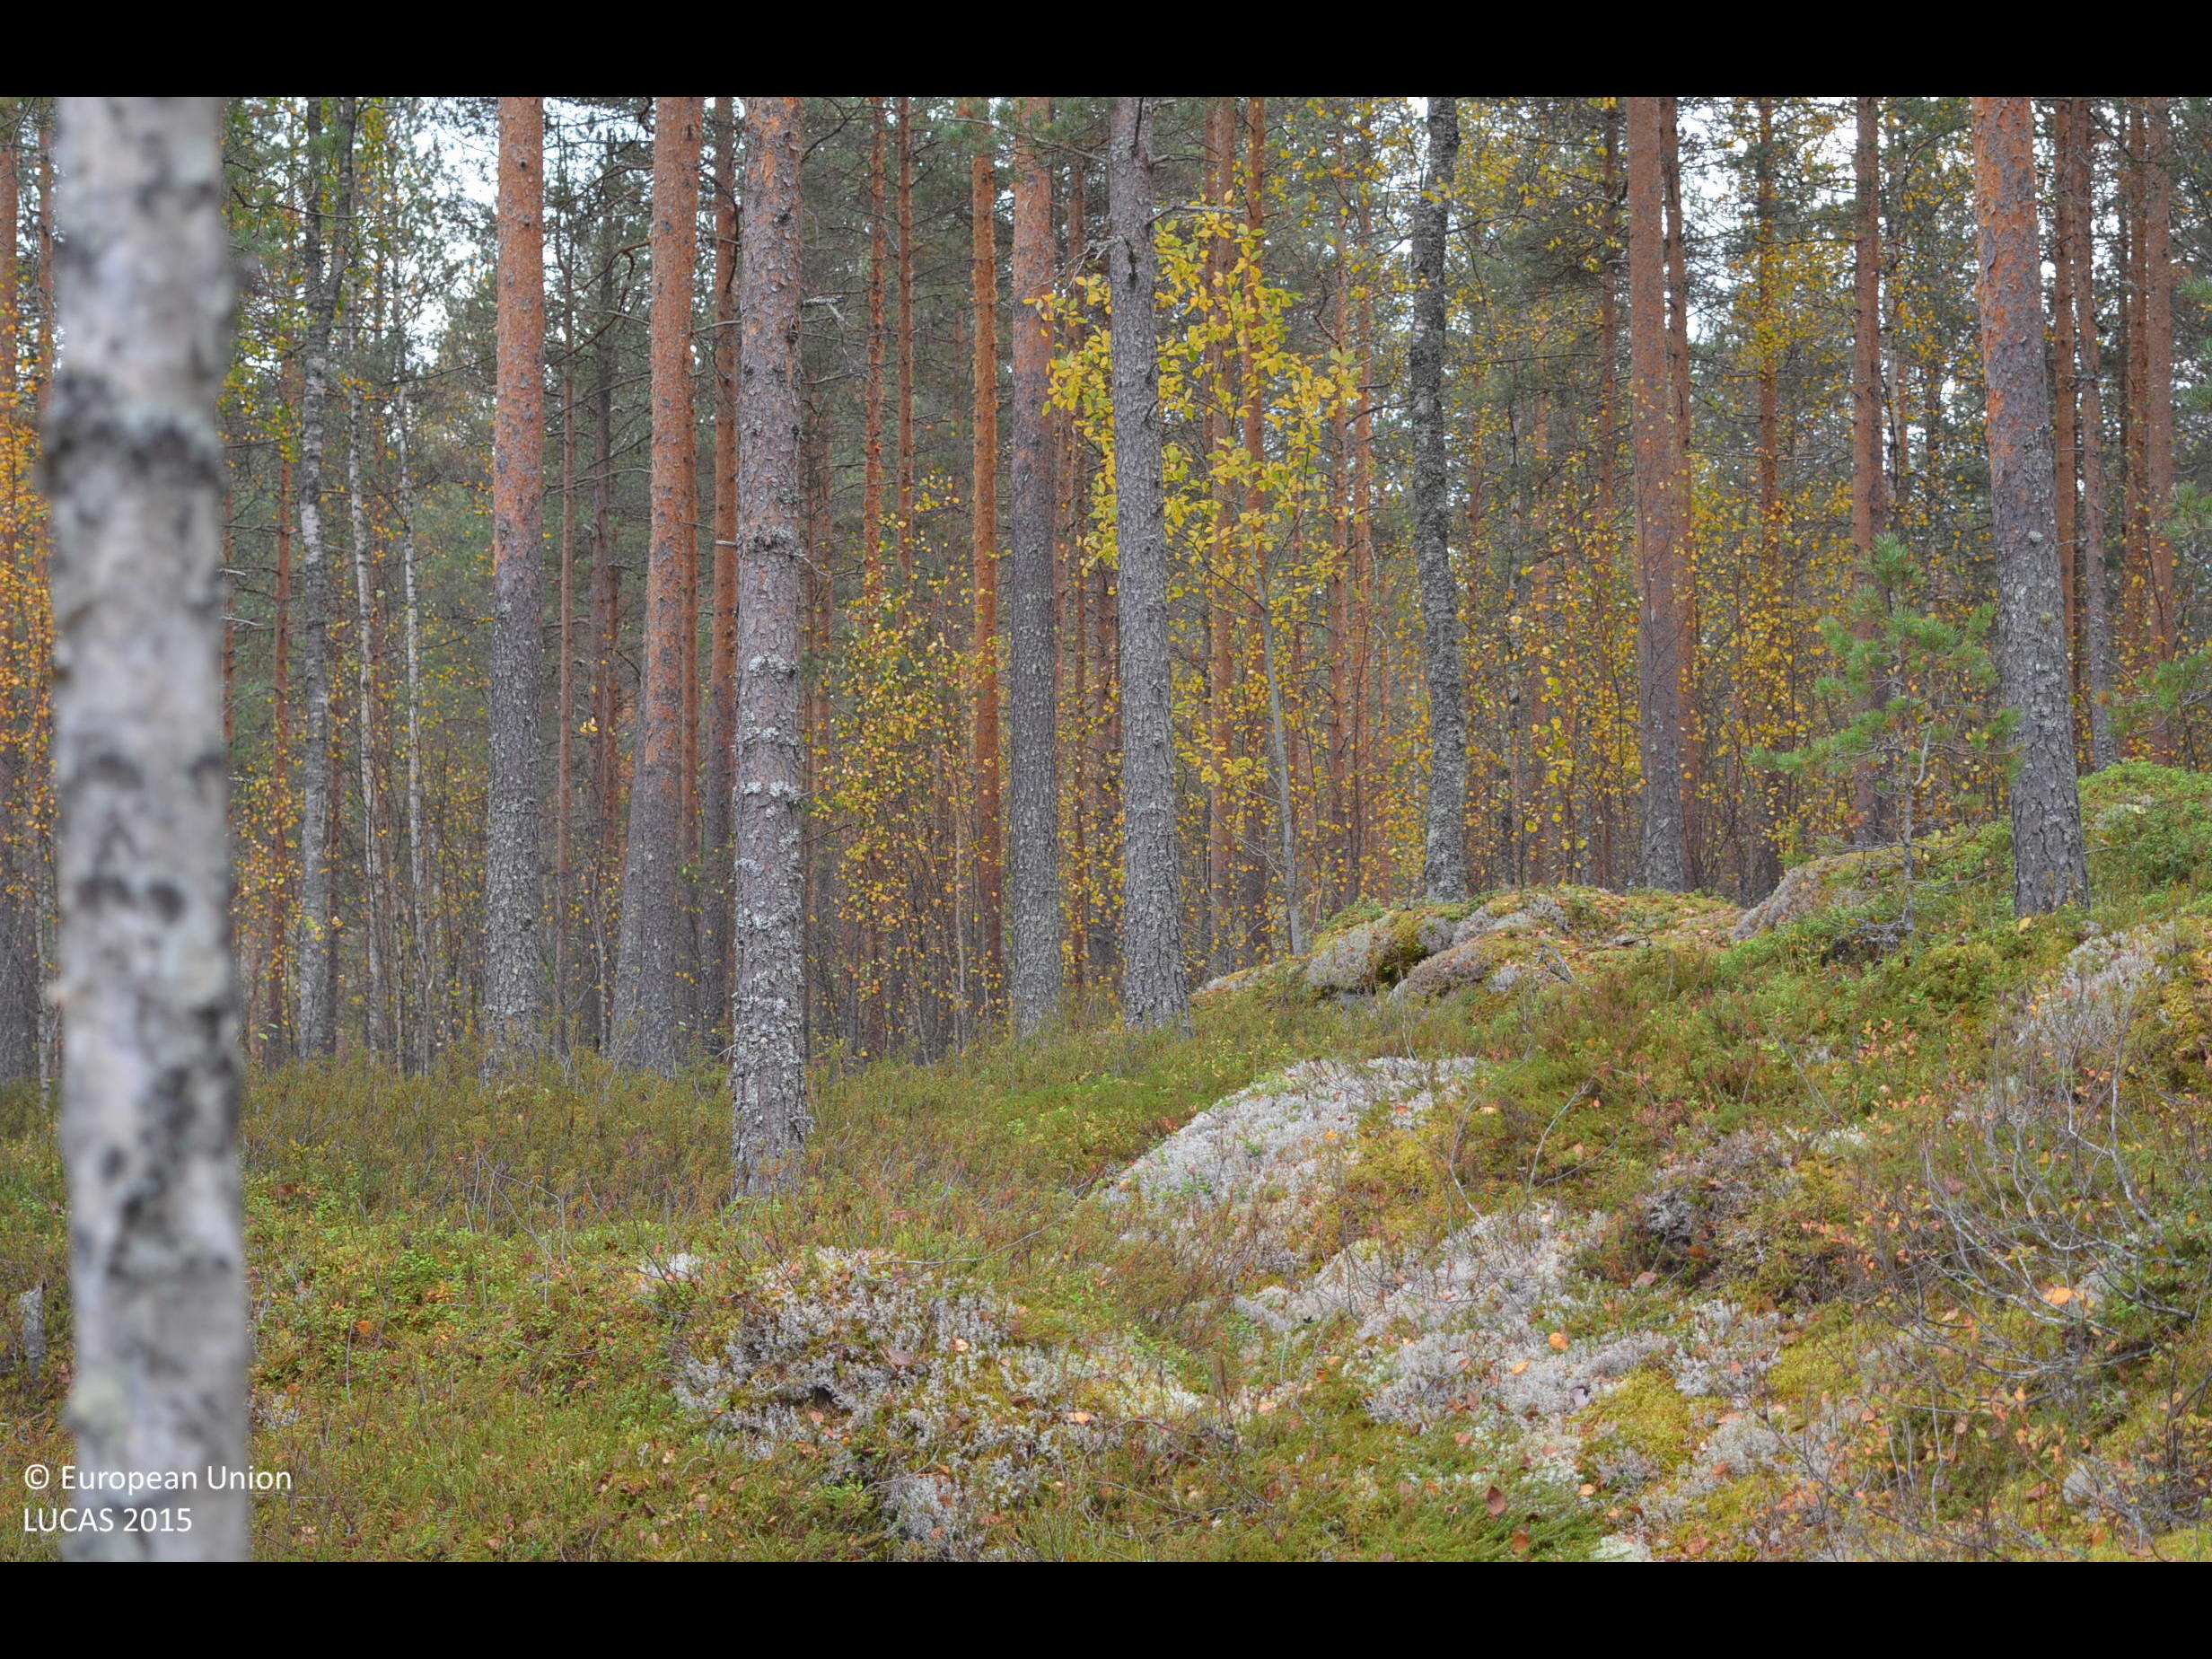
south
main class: Woodland
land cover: Pine dominated mixed woodland
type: boreal forest
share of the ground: 50 - 75 %
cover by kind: coniferous forest trees 50 %, shrubs 25 %, broadleaved forest trees 20 %, lichens and mosses 5 %
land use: Forestry
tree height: > 5 m
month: September
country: FI
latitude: 62.4308
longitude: 23.6116
